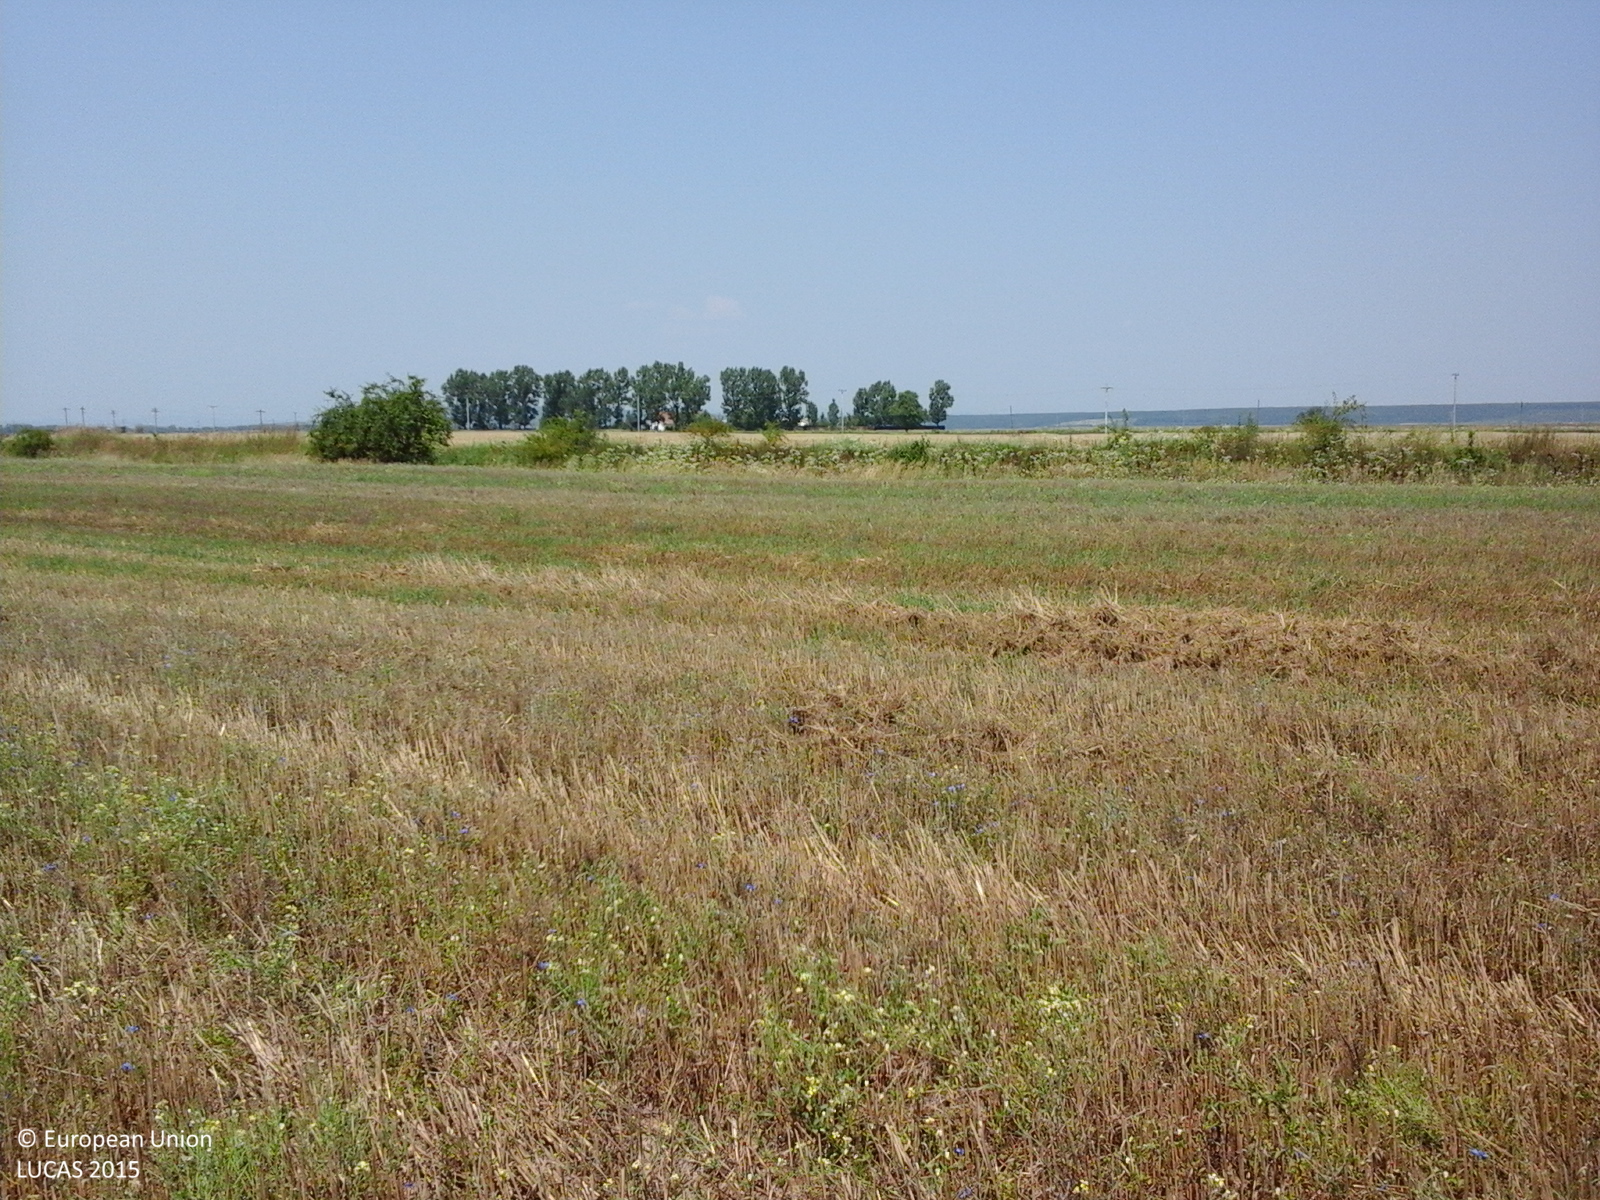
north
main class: Cropland
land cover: Common wheat
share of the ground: < 10 %
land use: Agriculture (excluding fallow land and kitchen gardens)
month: July
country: RO
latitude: 44.7996
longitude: 25.6863
